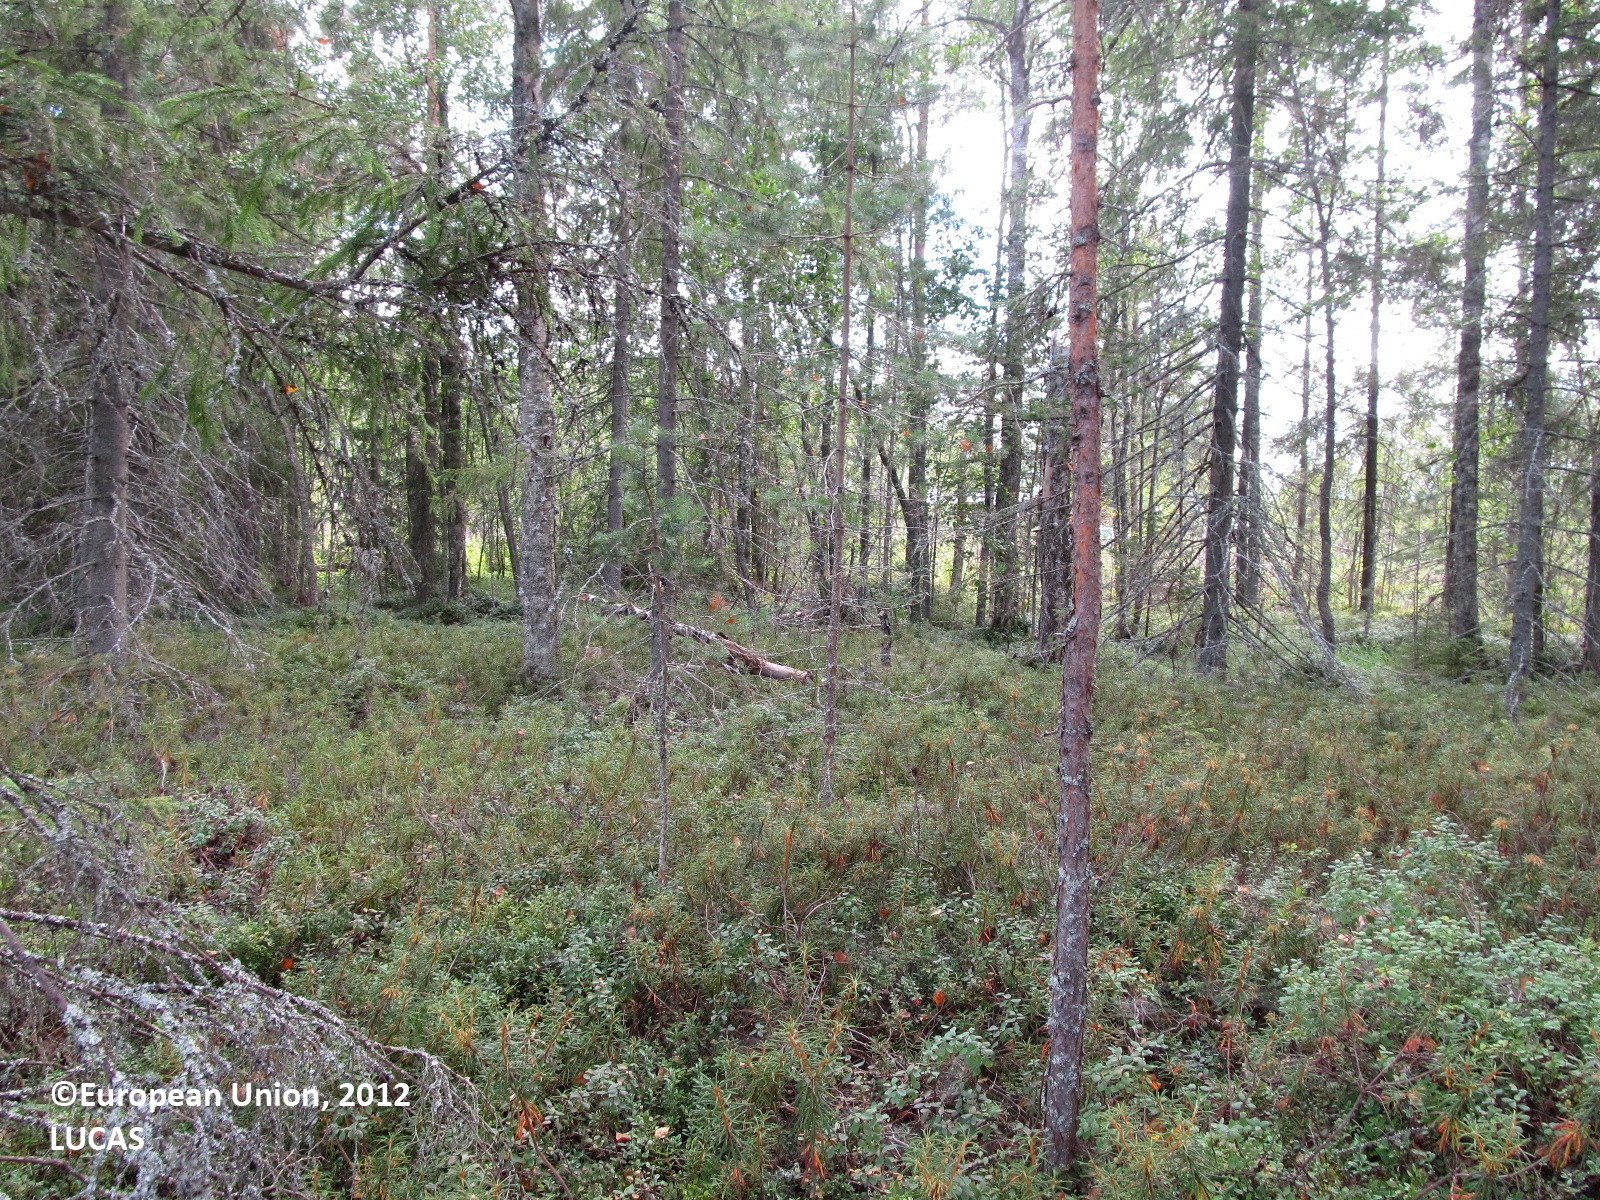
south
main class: Woodland
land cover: Spruce dominated mixed woodland
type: boreal forest
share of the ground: 50 - 75 %
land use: Forestry
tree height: > 5 m
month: August
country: FI
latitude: 61.9847
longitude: 27.4815
